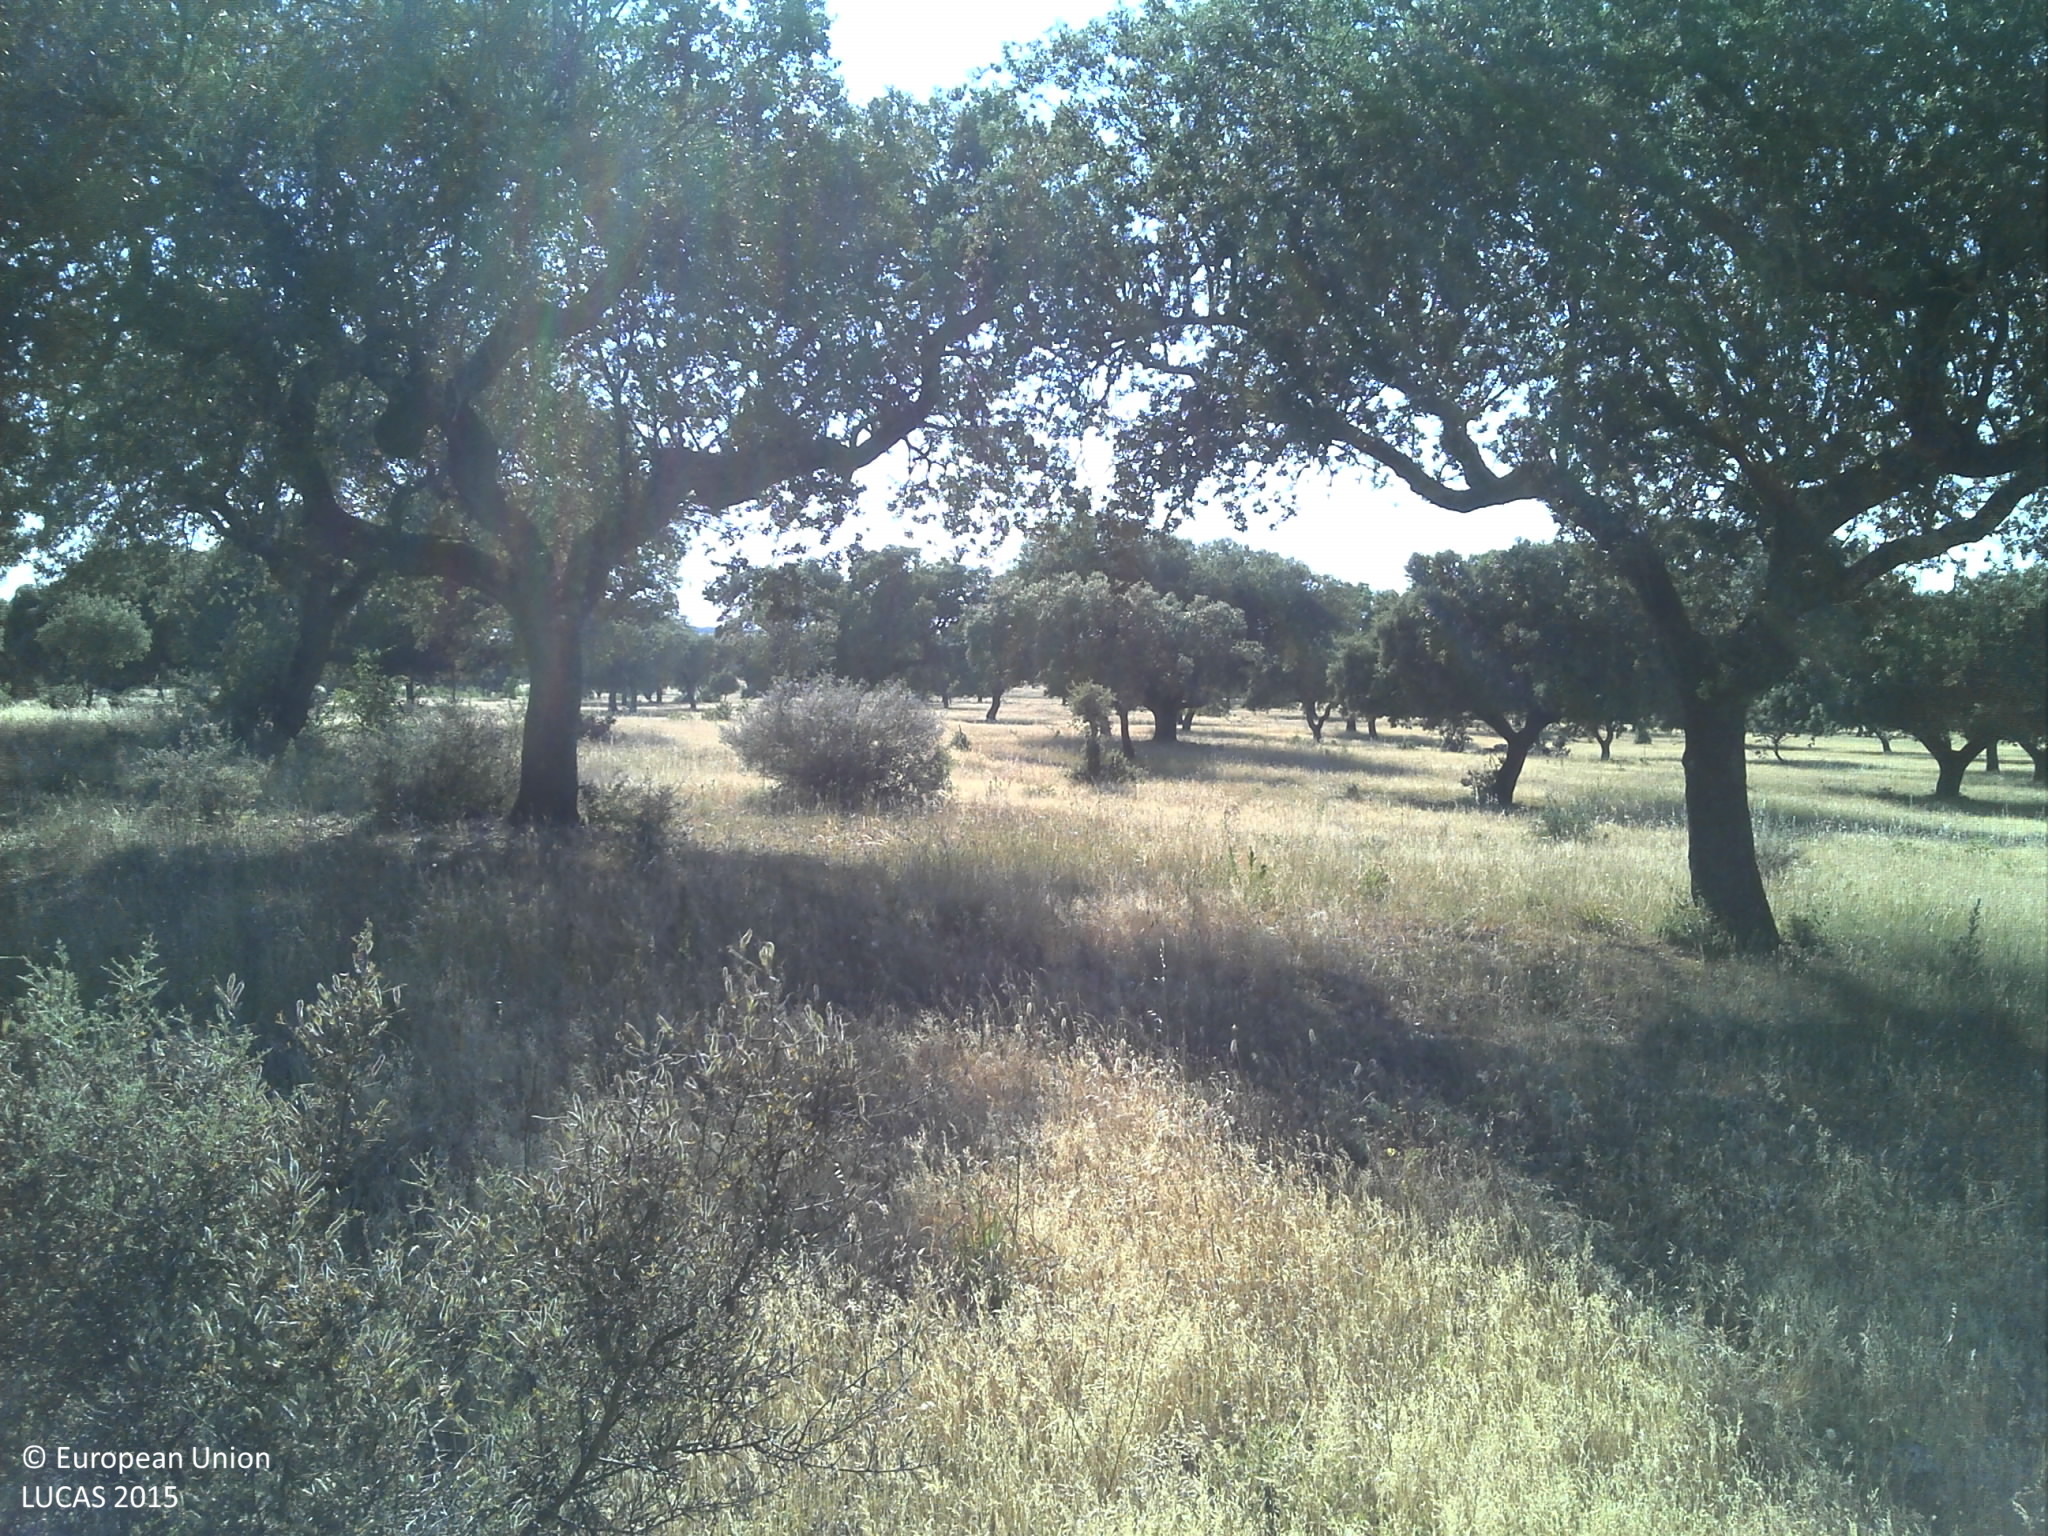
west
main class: Woodland
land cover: Broadleaved woodland
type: broadleaved evergreen forest
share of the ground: 25 - 50 %
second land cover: Grassland without tree/shrub cover
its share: 50 - 75 %
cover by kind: herbaceous plants 60 %, broadleaved forest trees 30 %, unconsolidated bare surface 10 %
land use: Forestry
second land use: Agriculture (excluding fallow land and kitchen gardens)
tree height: > 5 m
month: June
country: PT
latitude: 38.7306
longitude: -8.1193
